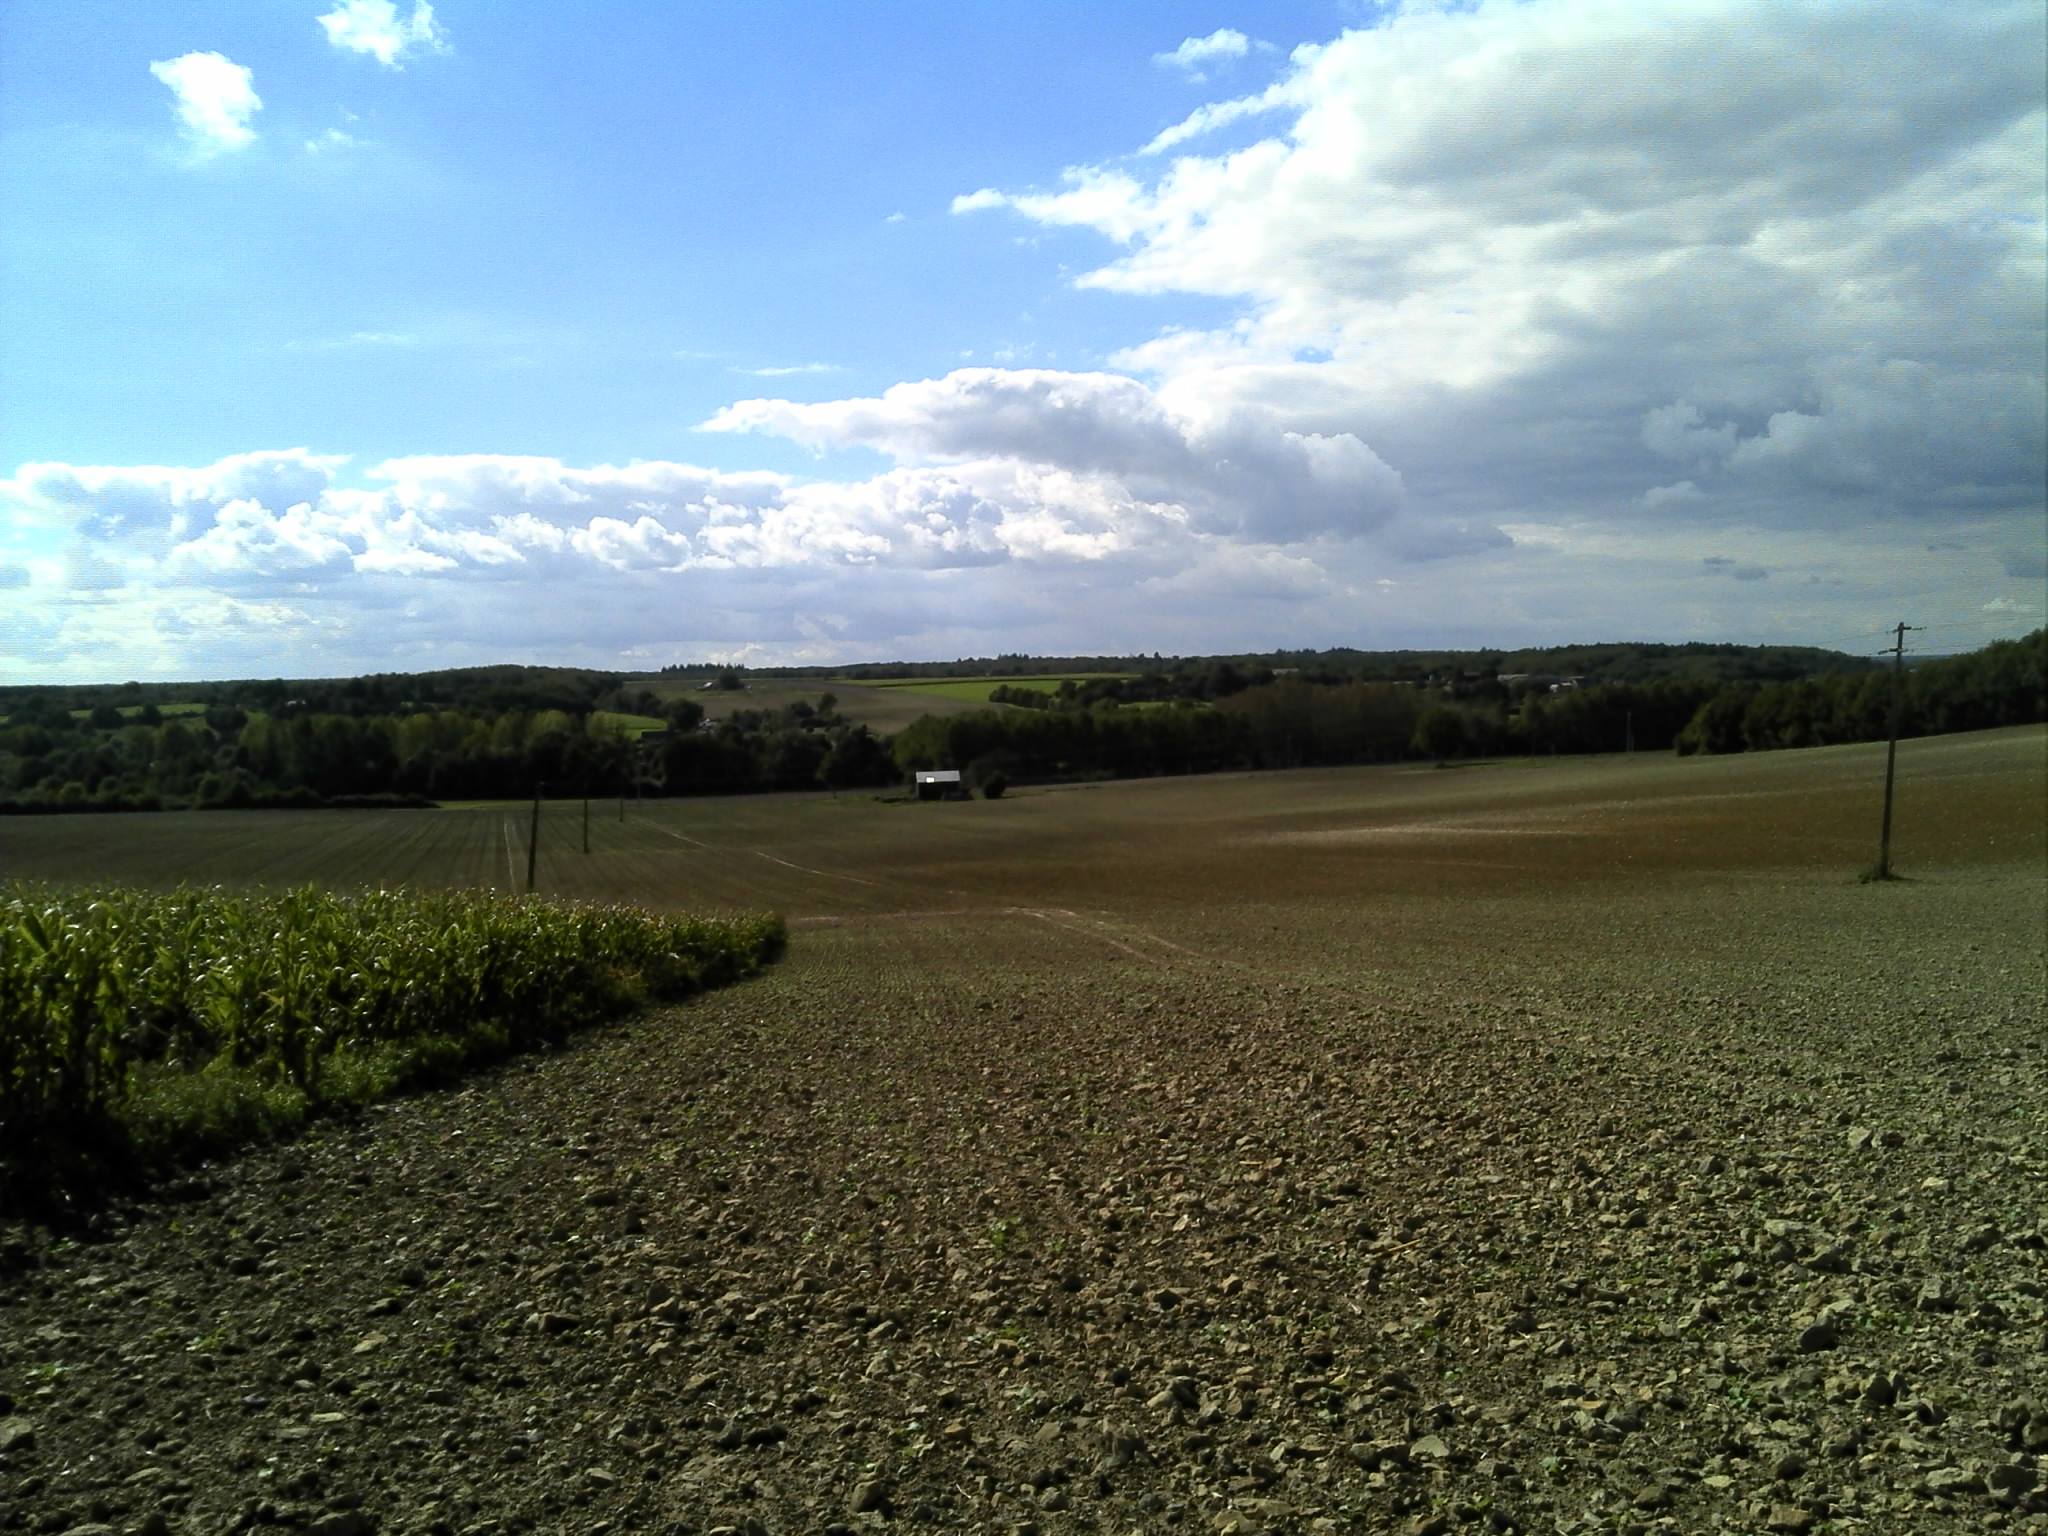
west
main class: Cropland
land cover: Other fibre and oleaginous crops
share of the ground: < 10 %
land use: Agriculture (excluding fallow land and kitchen gardens)
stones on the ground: > 50 %
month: September
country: FR
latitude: 47.6318
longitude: 0.3010
